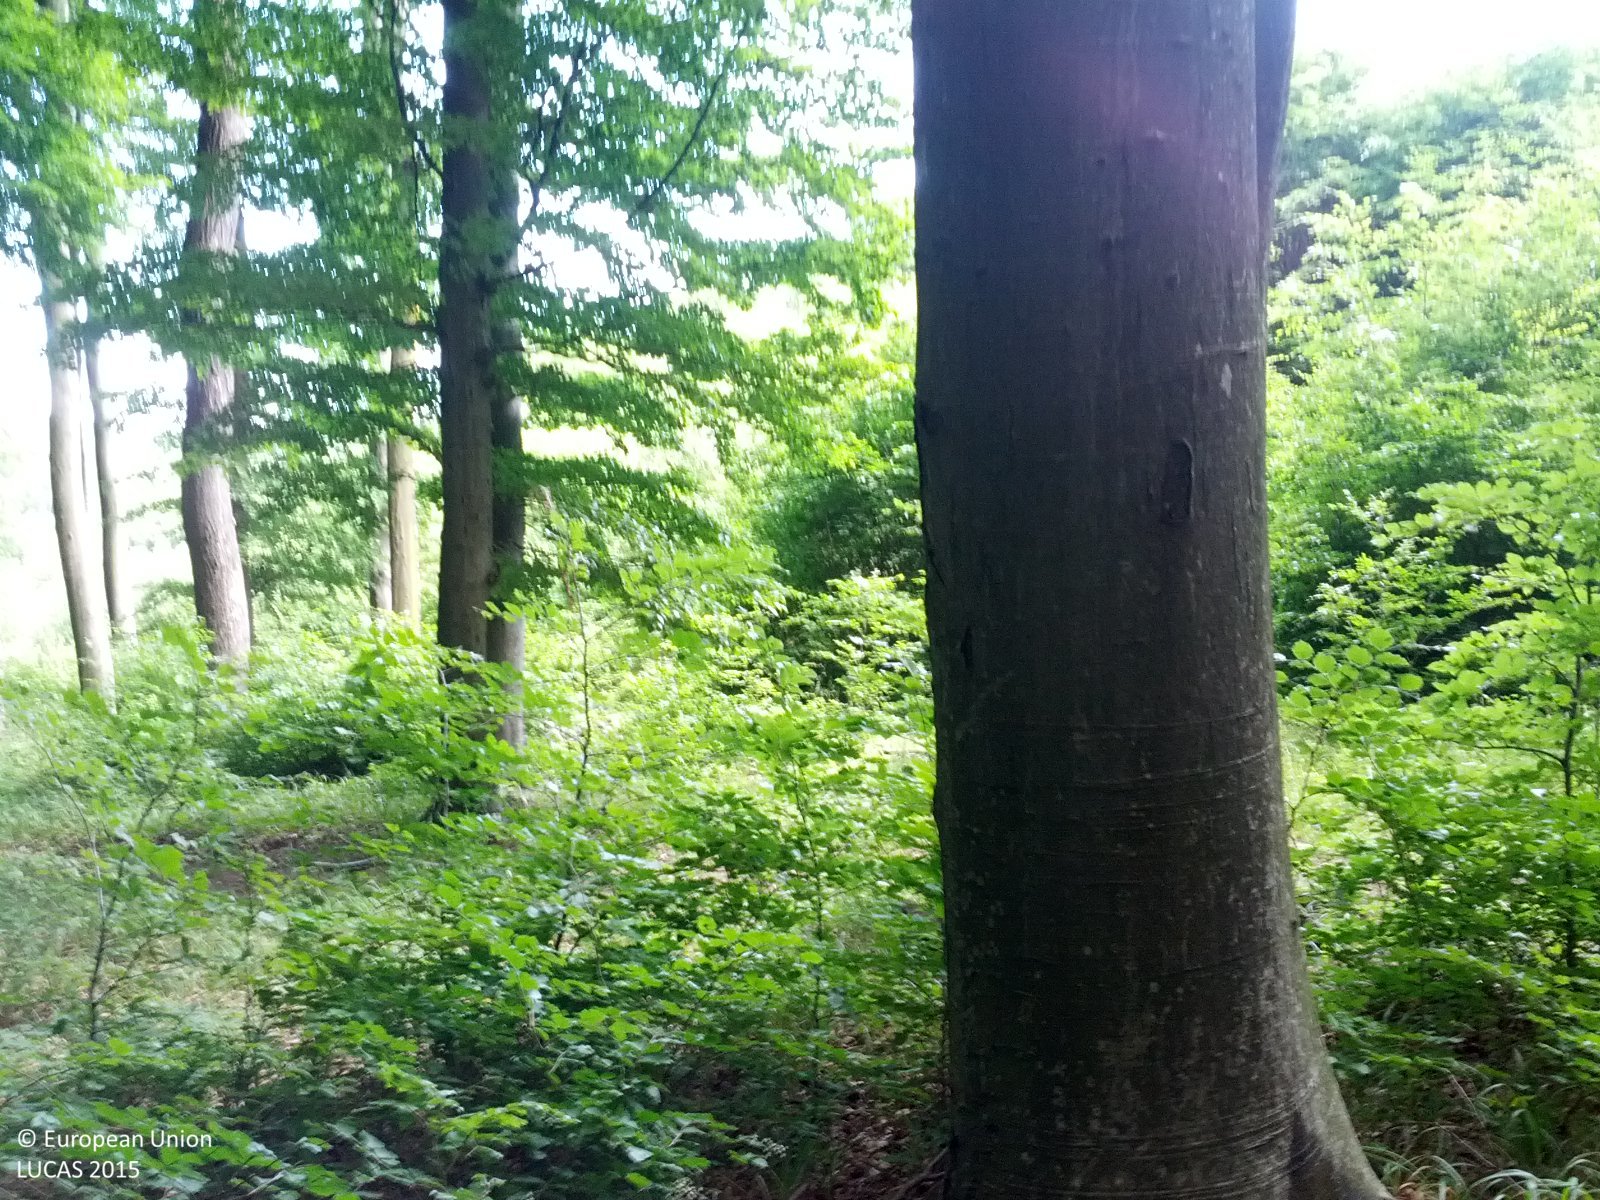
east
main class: Woodland
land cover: Broadleaved woodland
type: beech forest
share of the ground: > 75 %
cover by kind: broadleaved forest trees 80 %, herbaceous plants 15 %, shrubs 5 %
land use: Forestry
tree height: > 5 m
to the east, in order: Broadleaved woodland; Ditches and canals; Broadleaved woodland
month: June
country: AT
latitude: 48.2528
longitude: 16.1053
